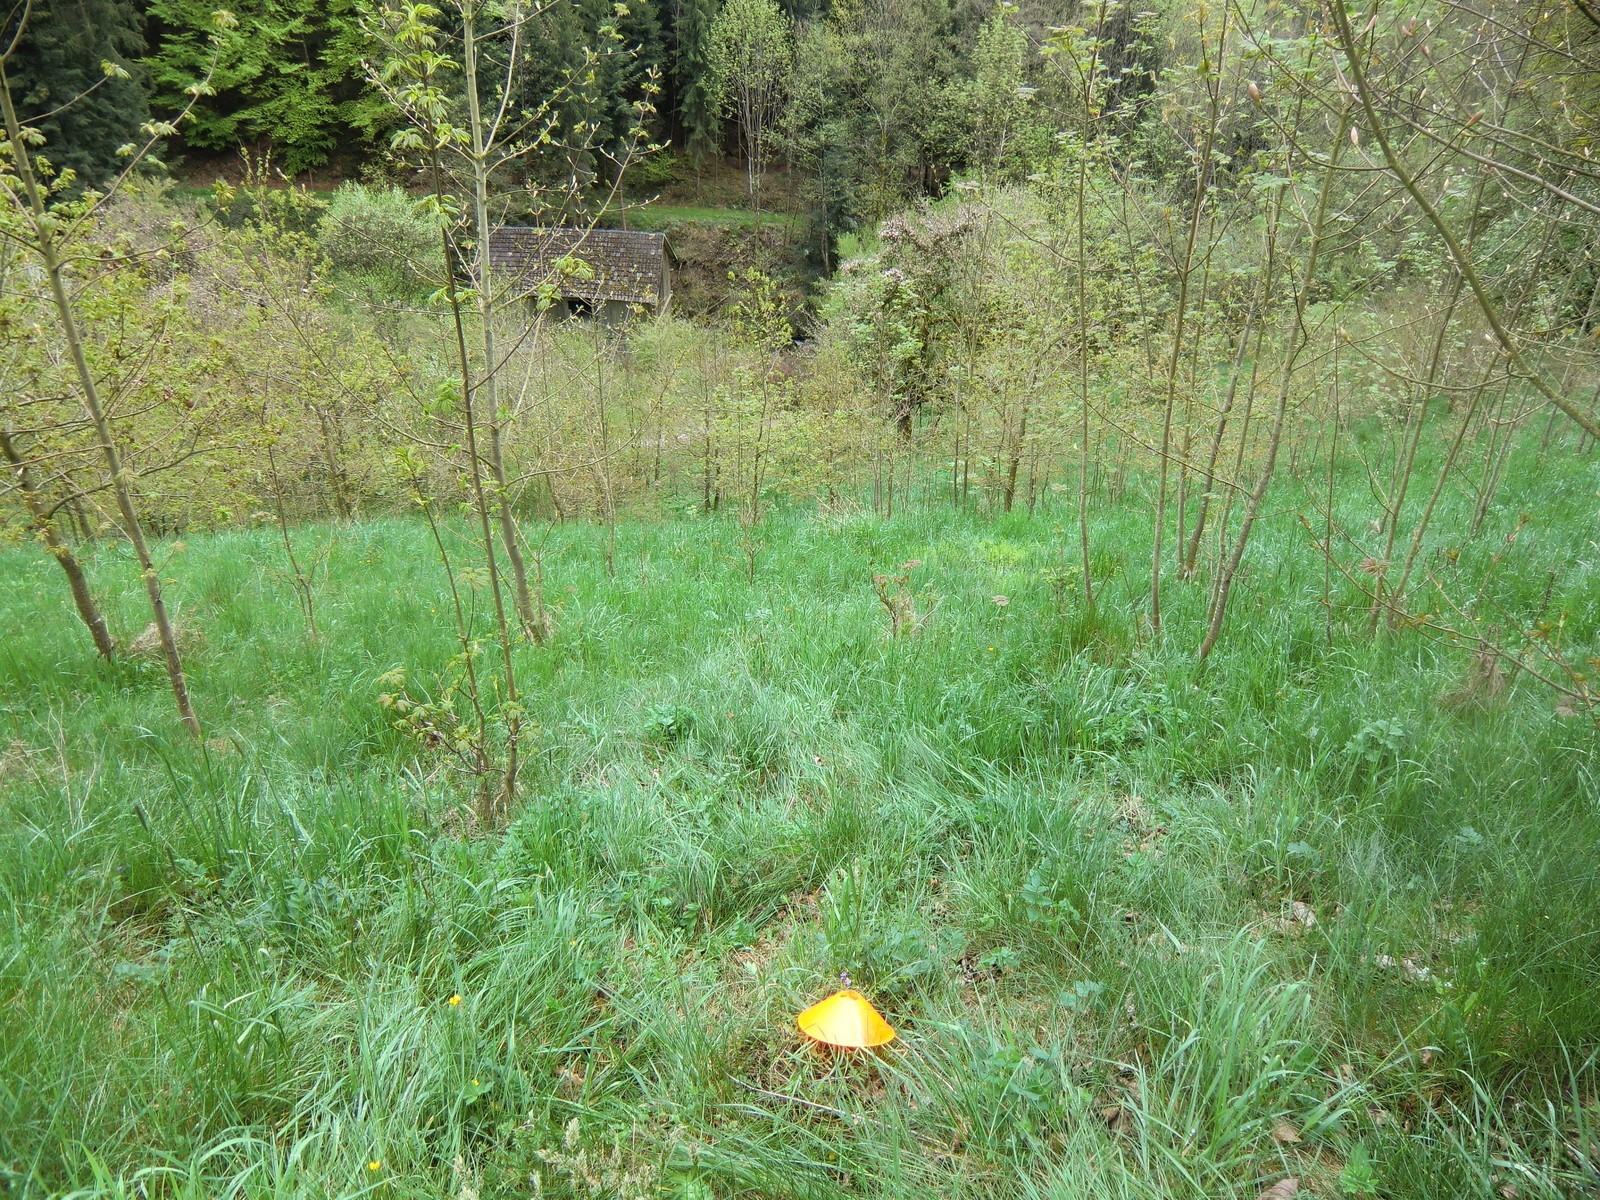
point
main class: Woodland
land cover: Broadleaved woodland
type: non-riverine alder, birch or aspen forest
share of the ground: 10 - 25 %
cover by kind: herbaceous plants 75 %, broadleaved forest trees 25 %
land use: Forestry
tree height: < 5 m
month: May
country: AT
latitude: 48.2999
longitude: 14.7866
